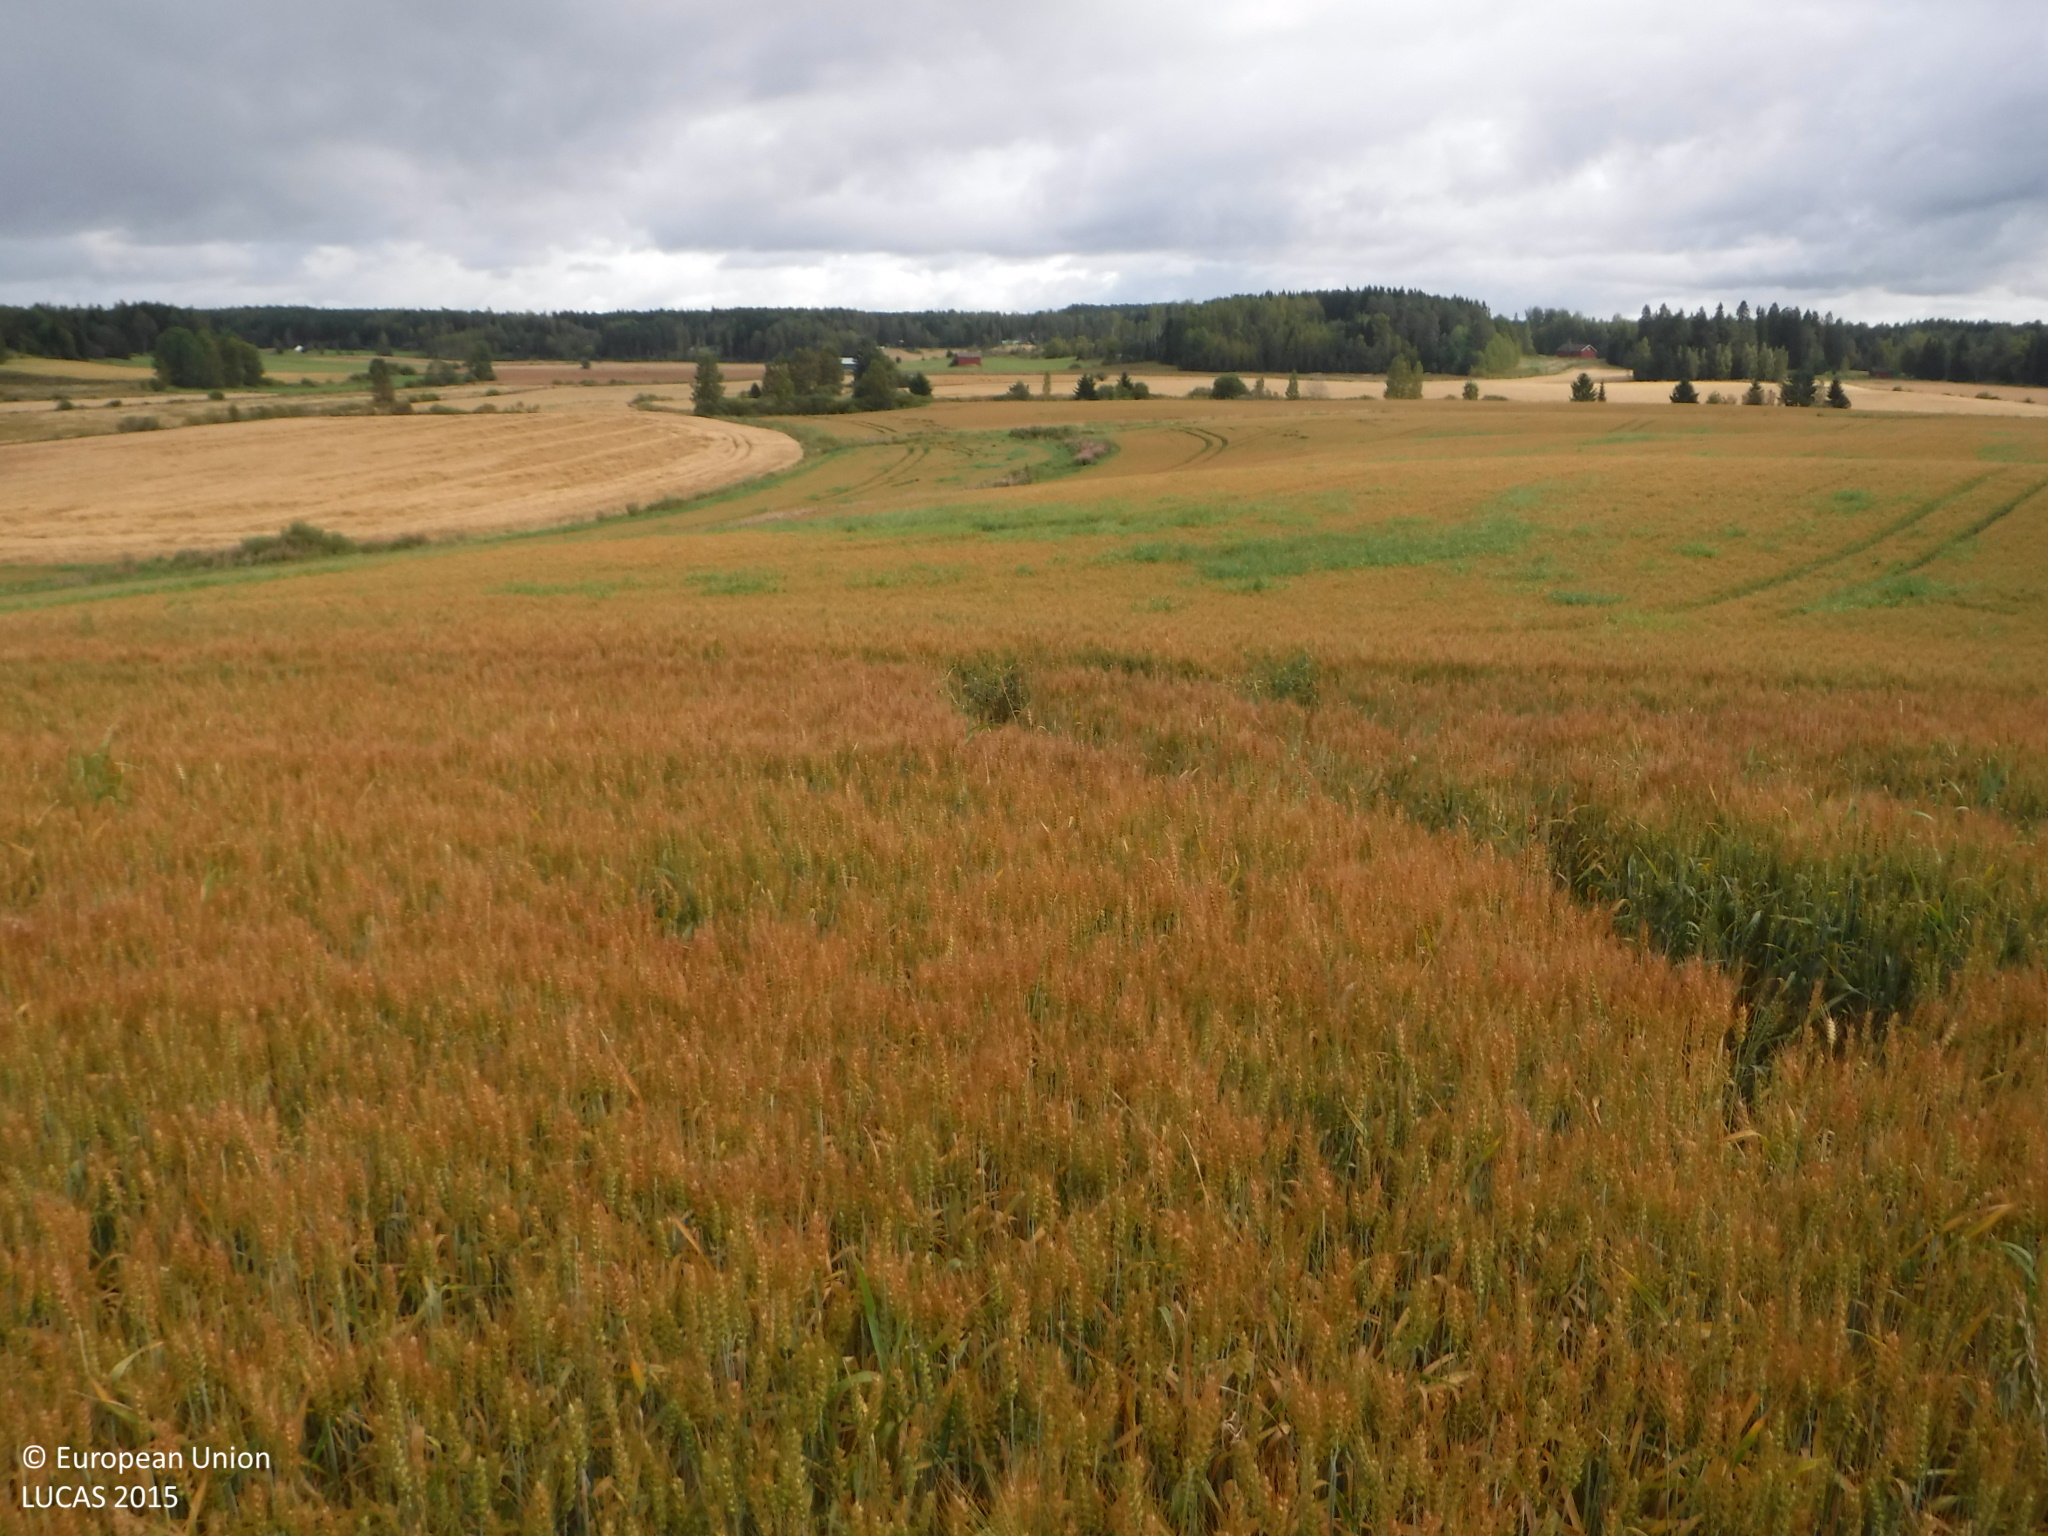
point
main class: Cropland
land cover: Common wheat
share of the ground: > 75 %
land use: Agriculture (excluding fallow land and kitchen gardens)
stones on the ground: < 10 %
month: September
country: FI
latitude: 61.3408
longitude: 23.1017
